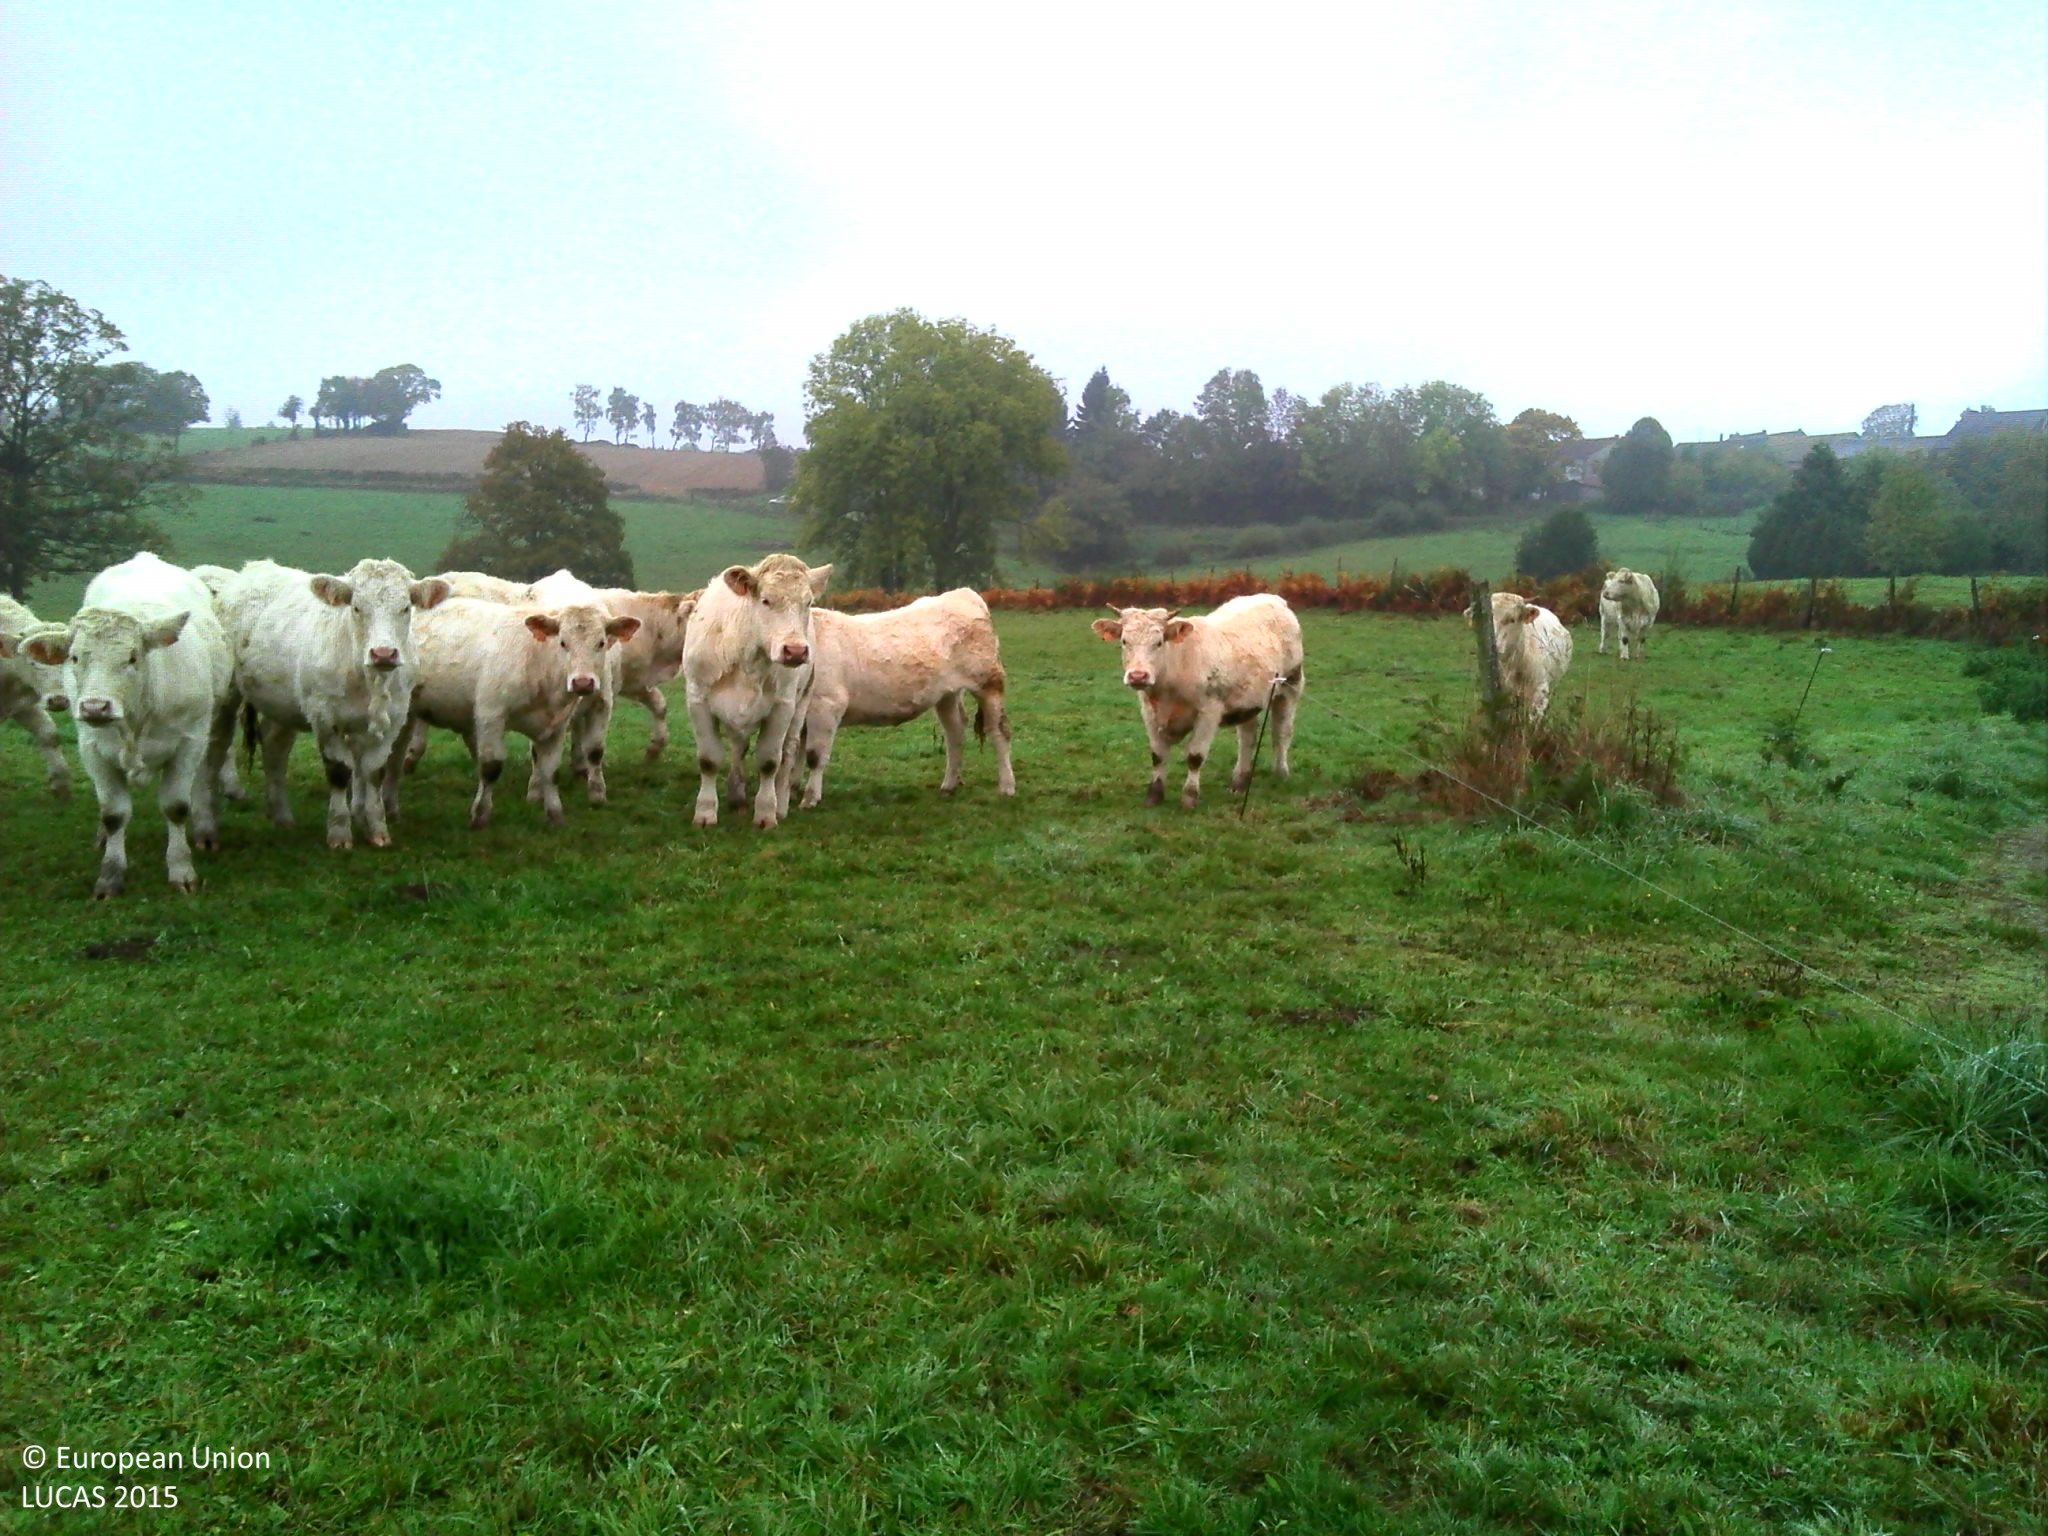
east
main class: Grassland
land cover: Grassland without tree/shrub cover
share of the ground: > 75 %
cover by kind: herbaceous plants 100 %
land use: Agriculture (excluding fallow land and kitchen gardens)
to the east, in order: Grassland without tree/shrub cover; Fences; Single bushes/trees; Fences; Spontaneously vegetated surfaces; Fences; Ditches and canals; Fences; Grassland without tree/shrub cover; Fences; Grassland without tree/shrub cover; Fences; Spontaneously vegetated surfaces; Tracks; Grass margins
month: October
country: FR
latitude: 45.9500
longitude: 2.8642
